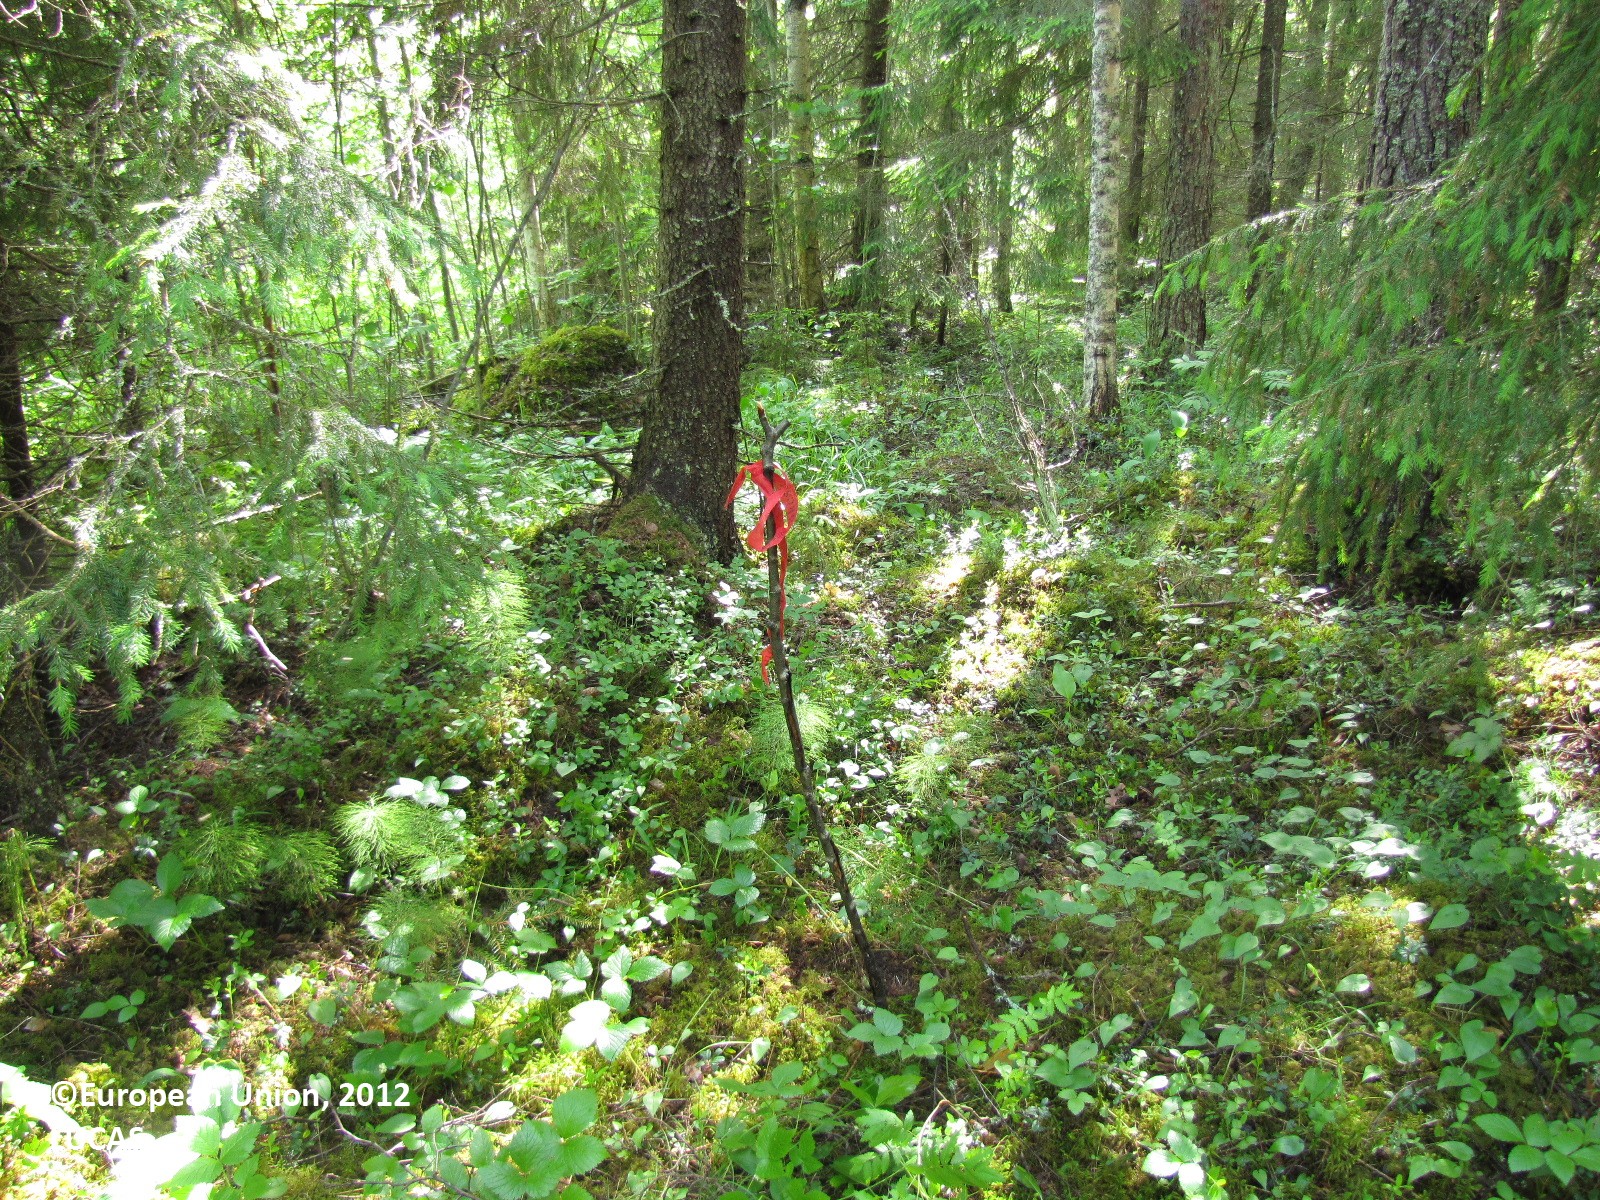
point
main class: Woodland
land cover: Spruce dominated coniferous woodland
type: boreal forest
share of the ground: 50 - 75 %
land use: Forestry
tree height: > 5 m
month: June
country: FI
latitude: 61.3234
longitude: 24.6176
